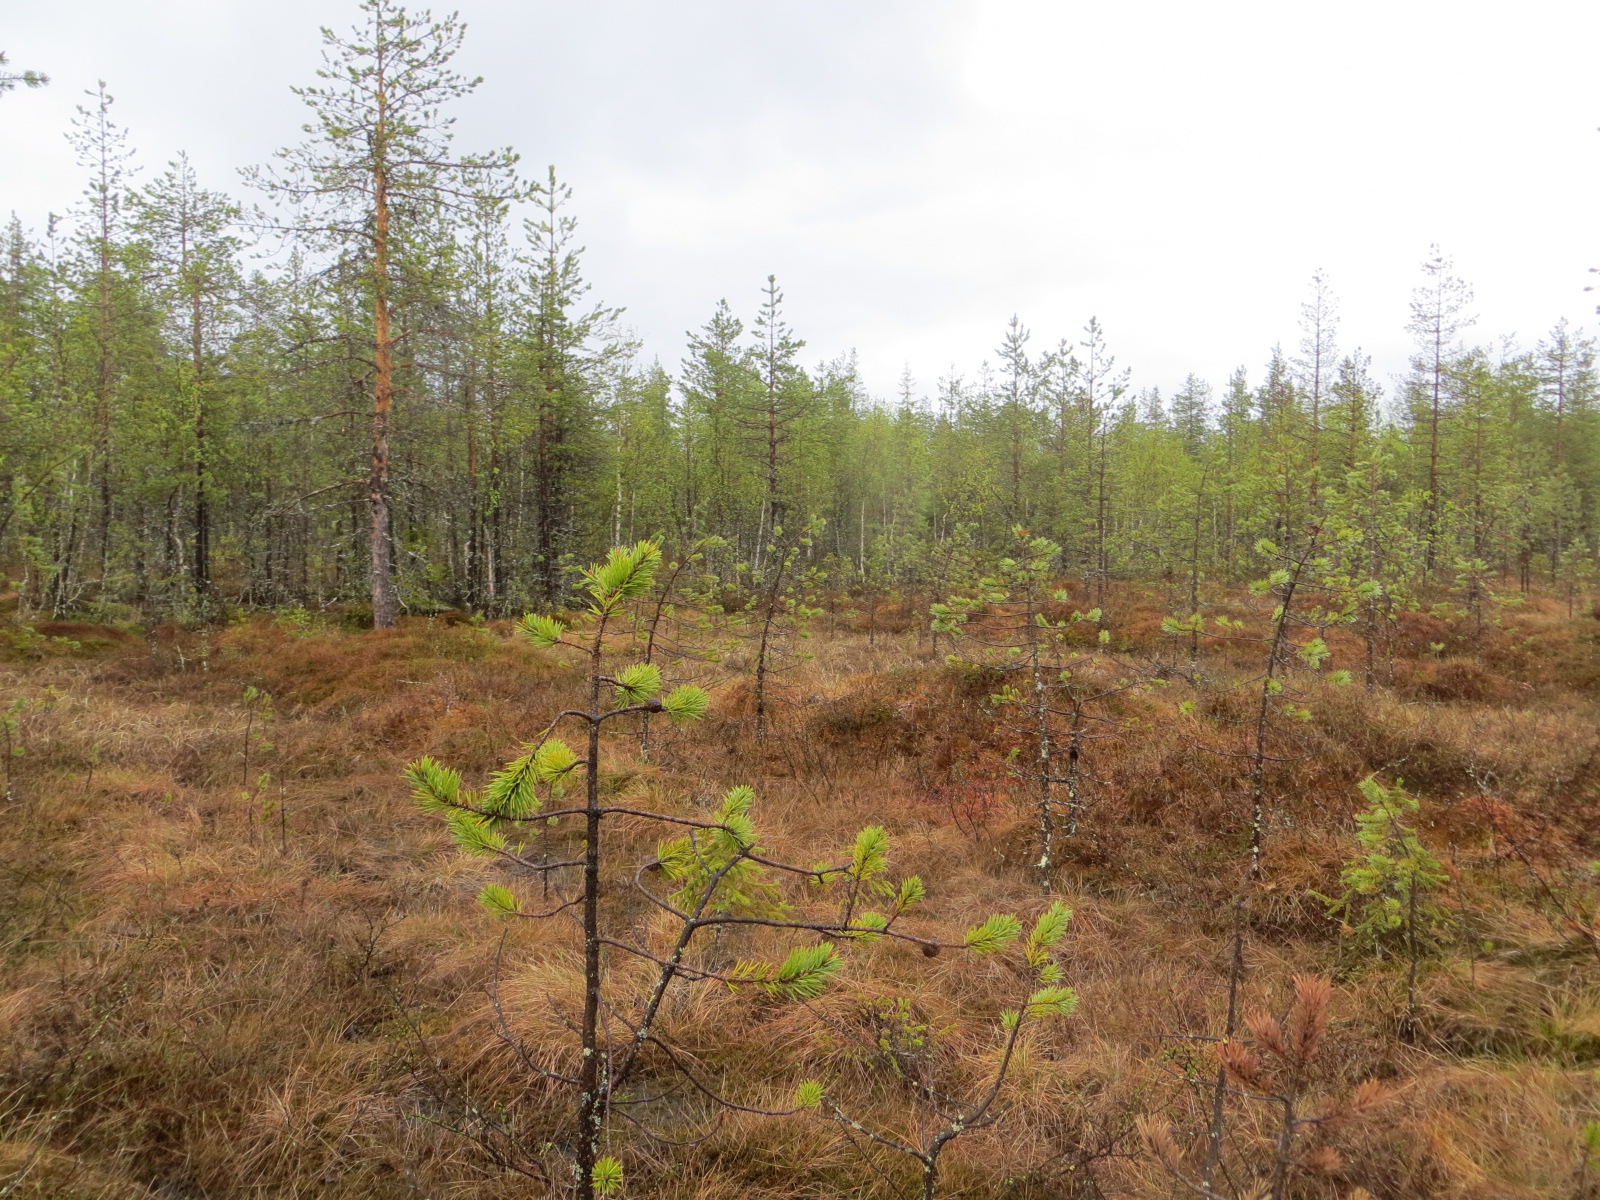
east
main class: Woodland
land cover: Pine dominated coniferous woodland
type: mire and swamp forests
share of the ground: 25 - 50 %
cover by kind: coniferous forest trees 40 %, shrubs 40 %, herbaceous plants 15 %, lichens and mosses 5 %
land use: Forestry
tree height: > 5 m
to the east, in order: Pine dominated coniferous woodland; Ditches and canals; Pine dominated coniferous woodland; Ditches and canals; Other mixed woodland; Ditches and canals; Other mixed woodland; Ditches and canals; Pine dominated coniferous woodland
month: June
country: FI
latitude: 66.9035
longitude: 25.3374
